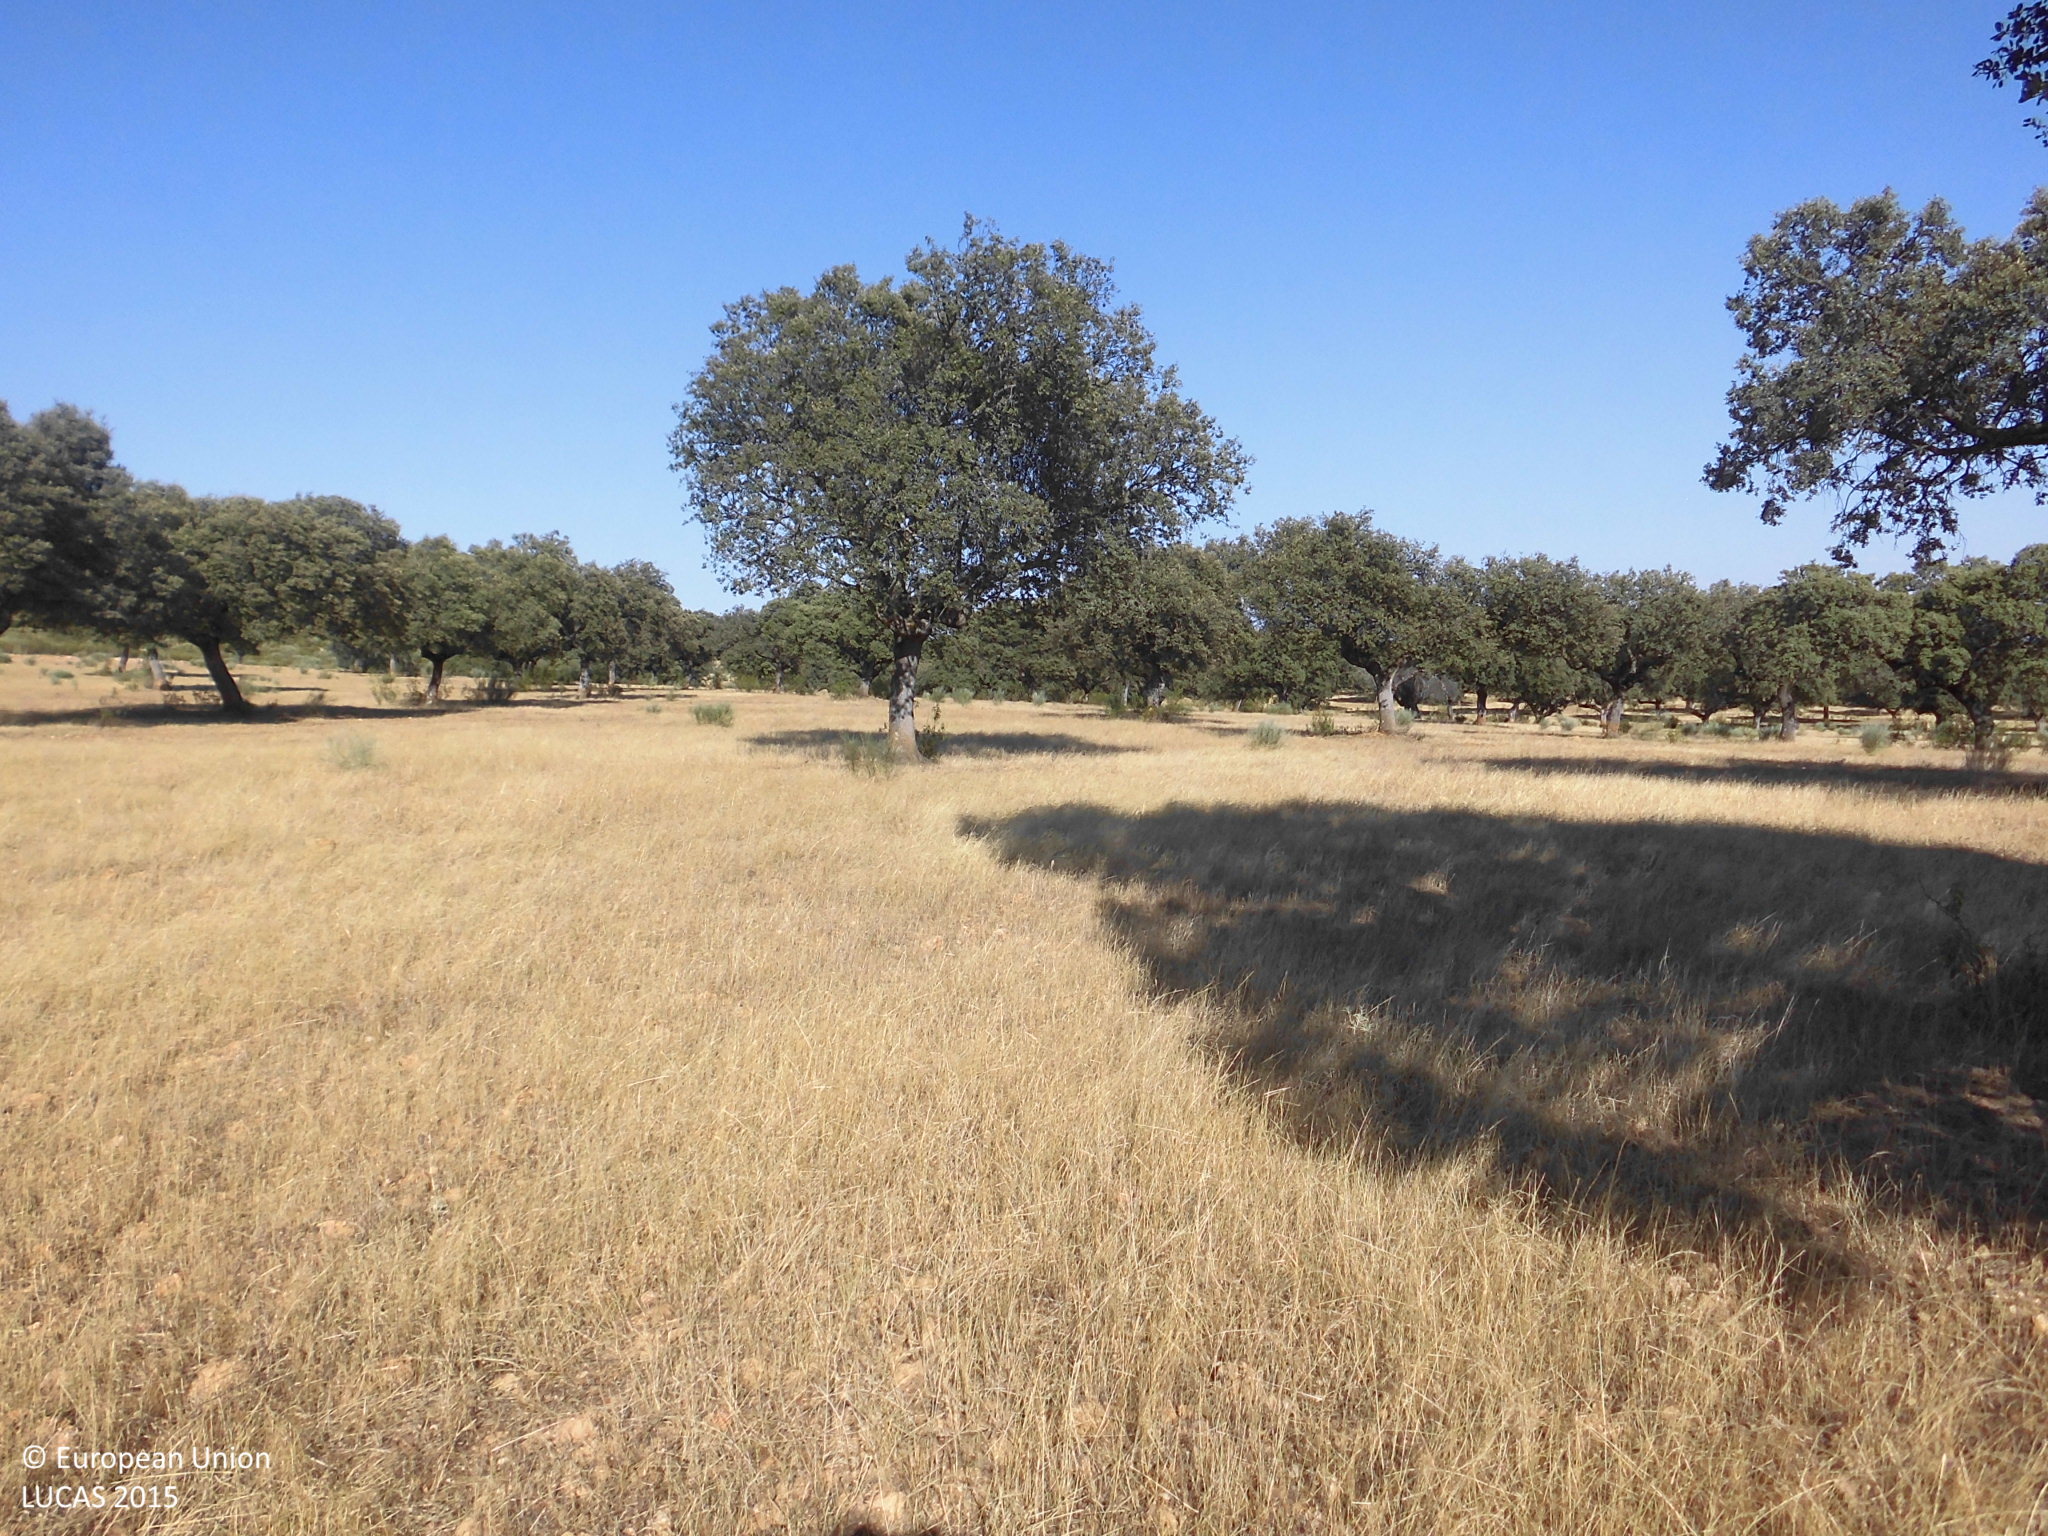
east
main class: Woodland
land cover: Broadleaved woodland
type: broadleaved evergreen forest
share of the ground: 10 - 25 %
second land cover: Grassland without tree/shrub cover
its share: > 75 %
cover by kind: herbaceous plants 75 %, broadleaved forest trees 25 %
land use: Forestry
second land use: Agriculture (excluding fallow land and kitchen gardens)
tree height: > 5 m
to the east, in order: Broadleaved woodland; Grassland without tree/shrub cover; Broadleaved woodland; Rivers and streams; Broadleaved woodland
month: June
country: ES
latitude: 39.7977
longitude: -5.9602
